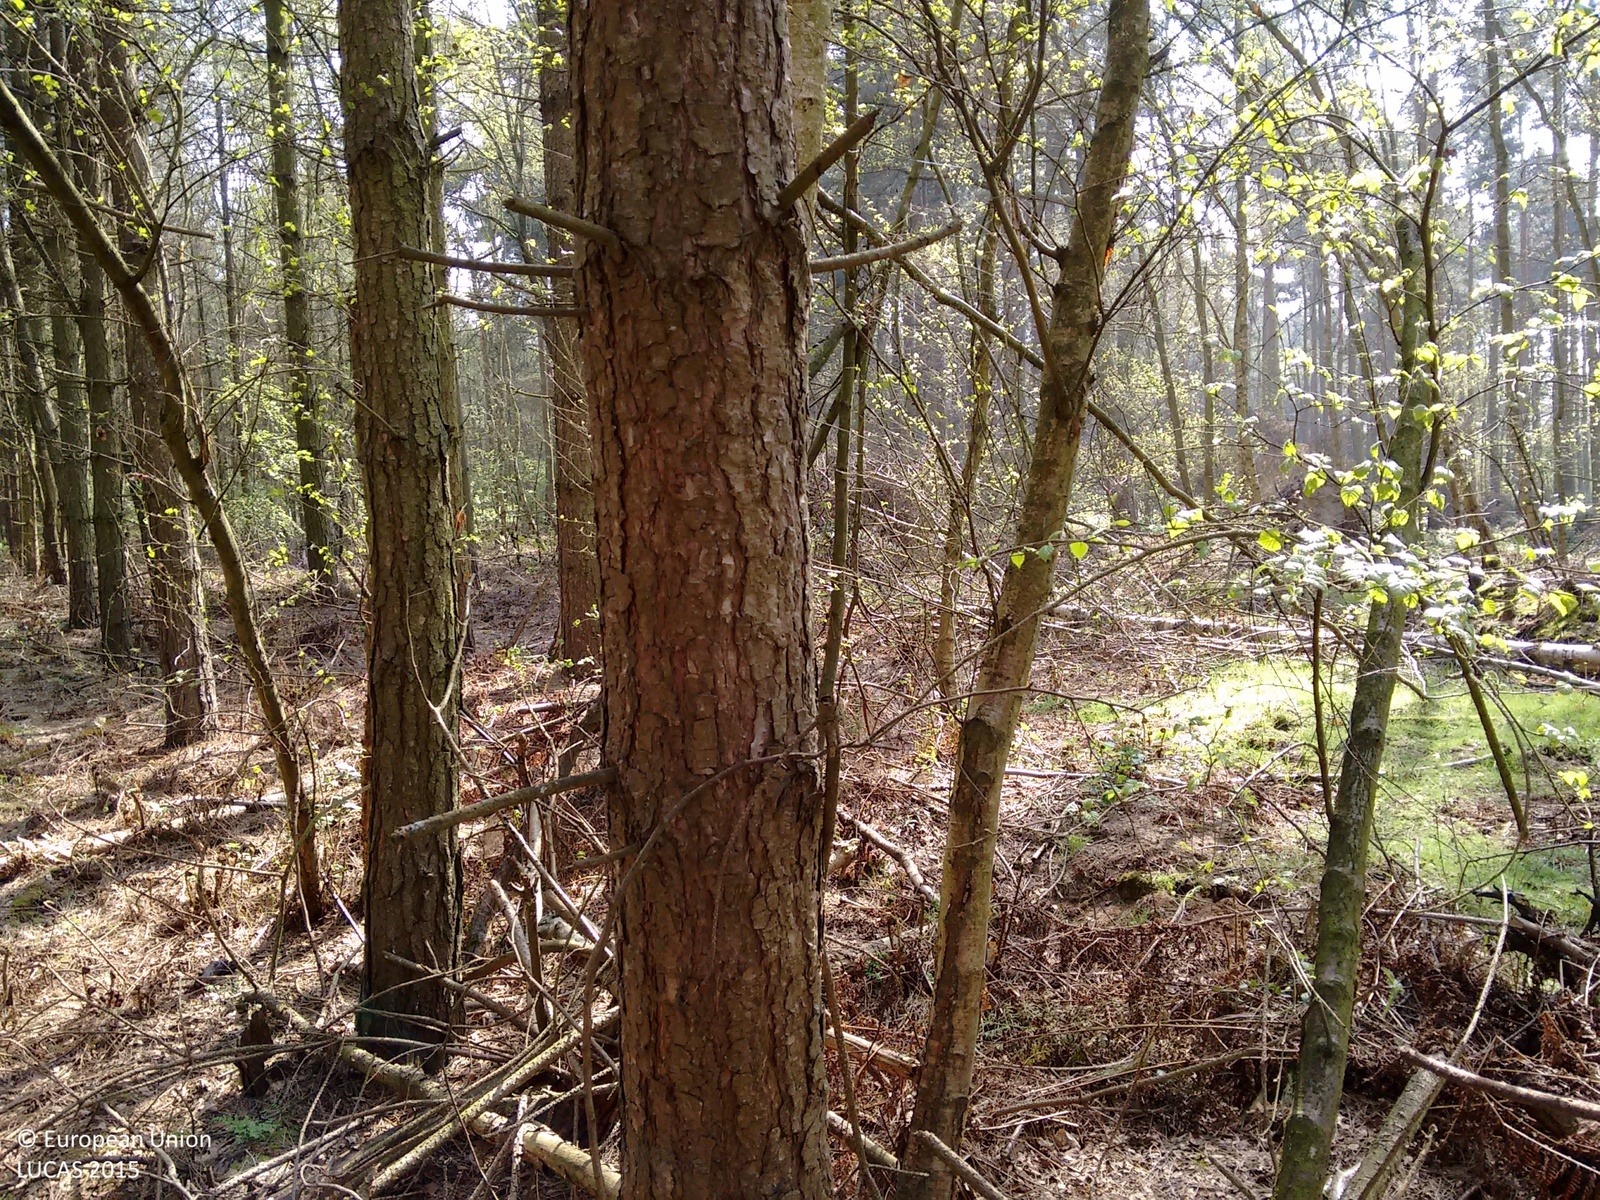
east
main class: Woodland
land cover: Pine dominated coniferous woodland
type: hemiboreal forest and nemoral coniferous forest and mixed broadleaved-coniferous forest
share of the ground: > 75 %
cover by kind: coniferous forest trees 75 %, broadleaved forest trees 25 %
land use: Forestry
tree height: > 5 m
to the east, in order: Pine dominated coniferous woodland; Tracks; Pine dominated coniferous woodland
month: April
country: GB
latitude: 53.4662
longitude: -0.7504
